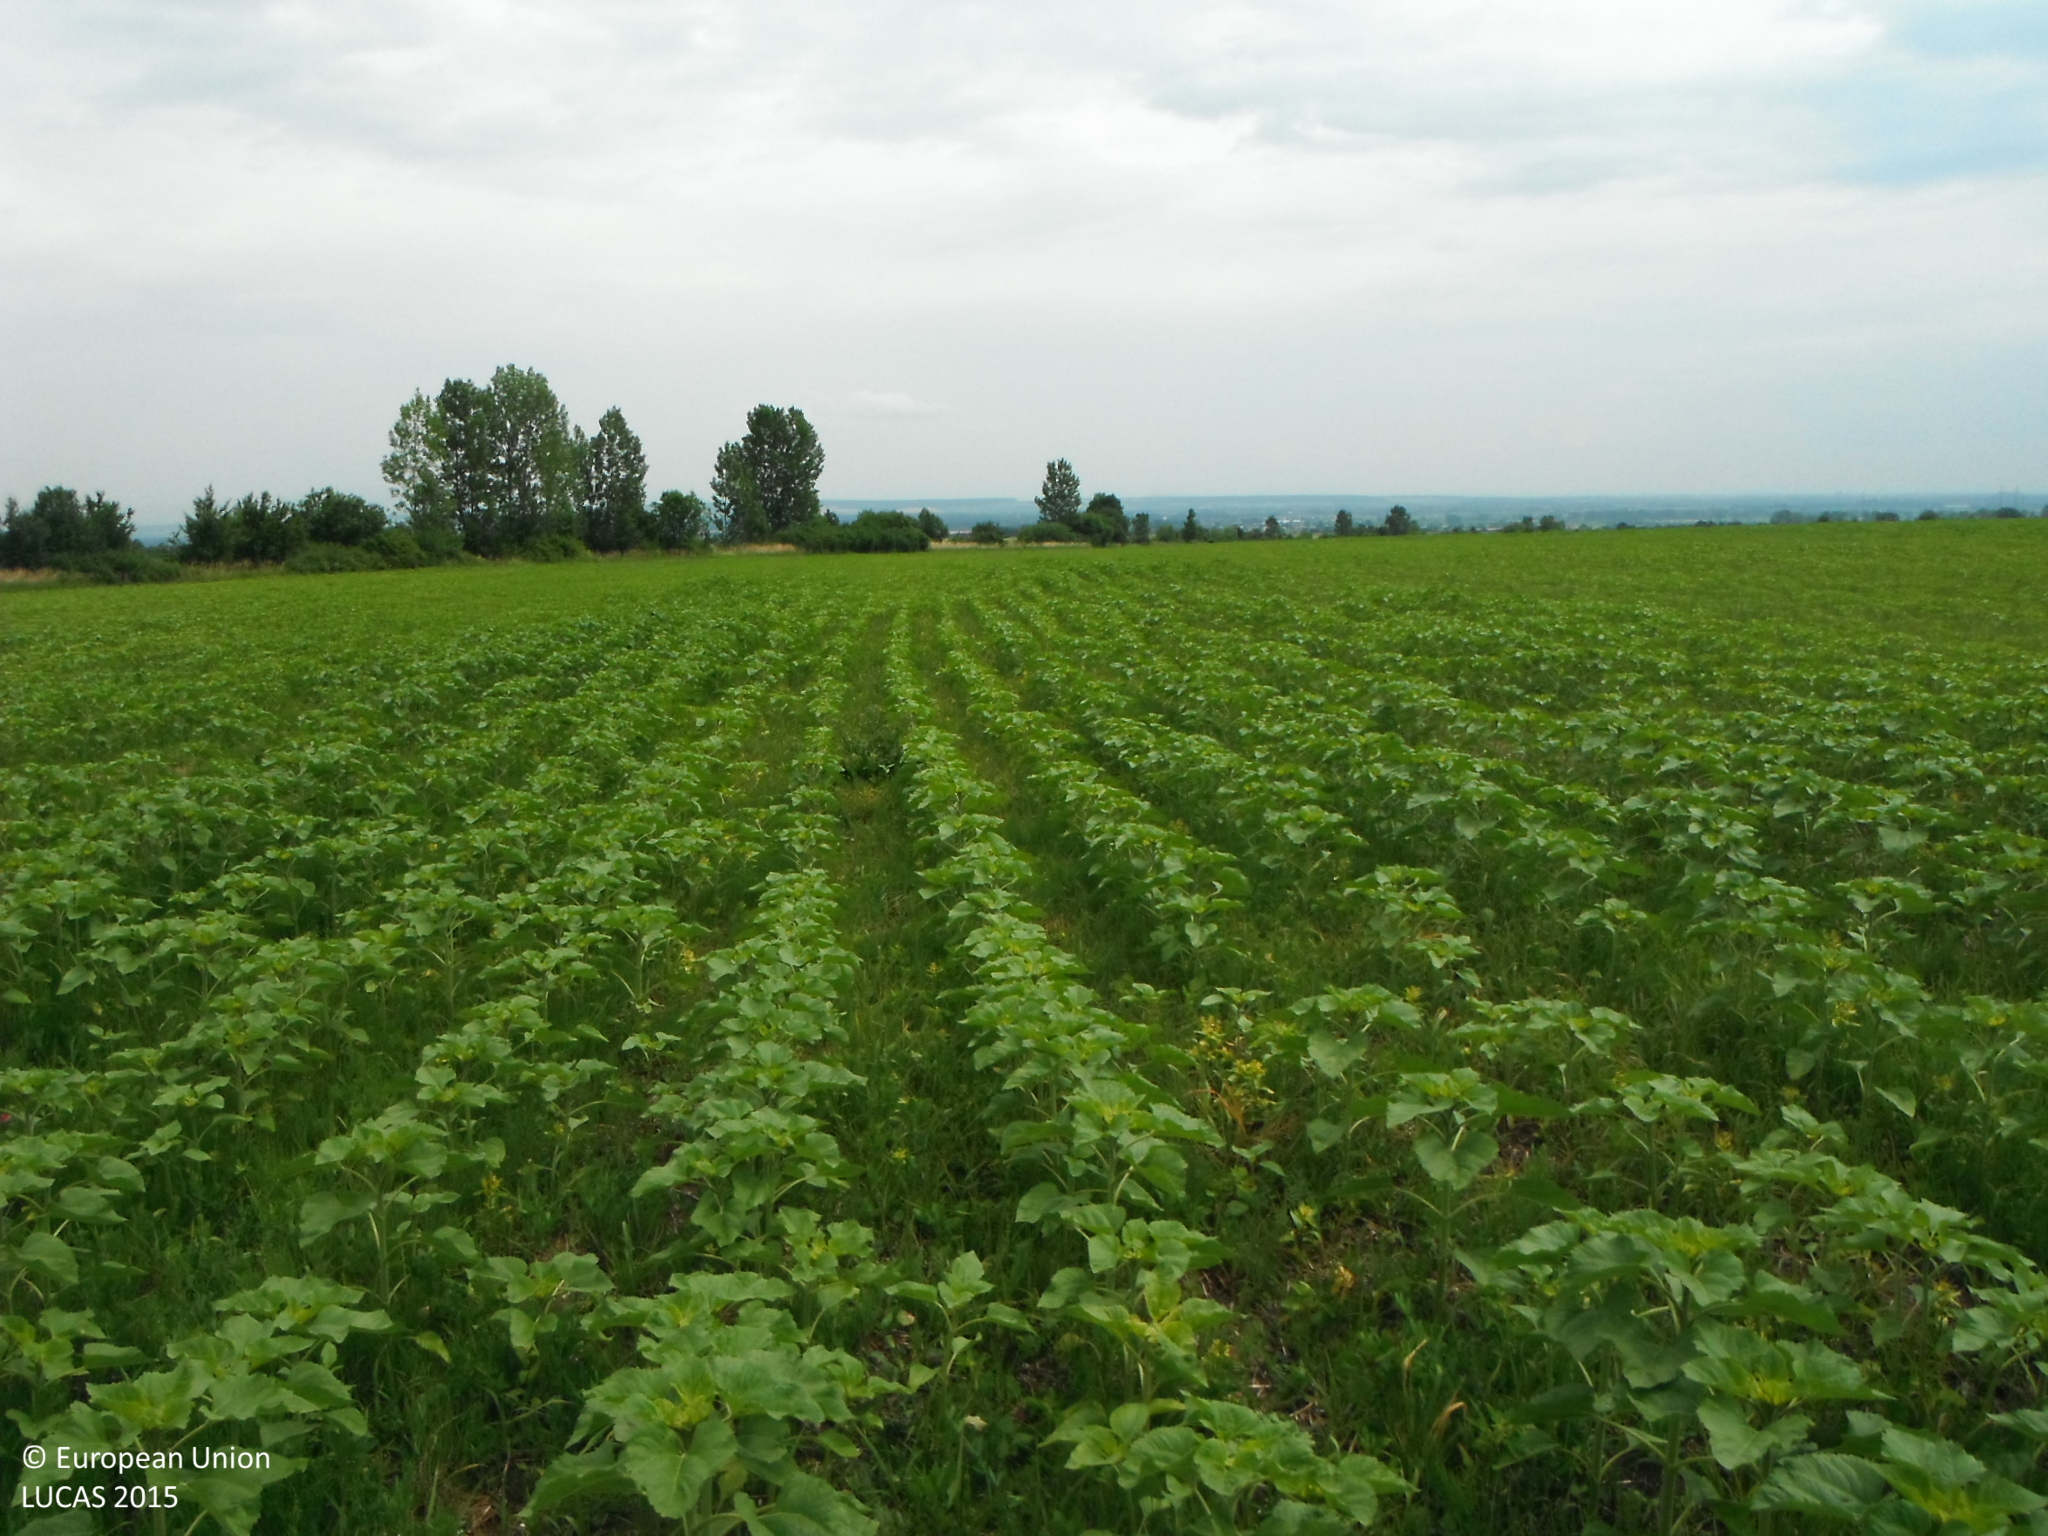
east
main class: Cropland
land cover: Sunflower
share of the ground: 50 - 75 %
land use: Agriculture (excluding fallow land and kitchen gardens)
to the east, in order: Sunflower
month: June
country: SK
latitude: 48.7336
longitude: 21.6199
